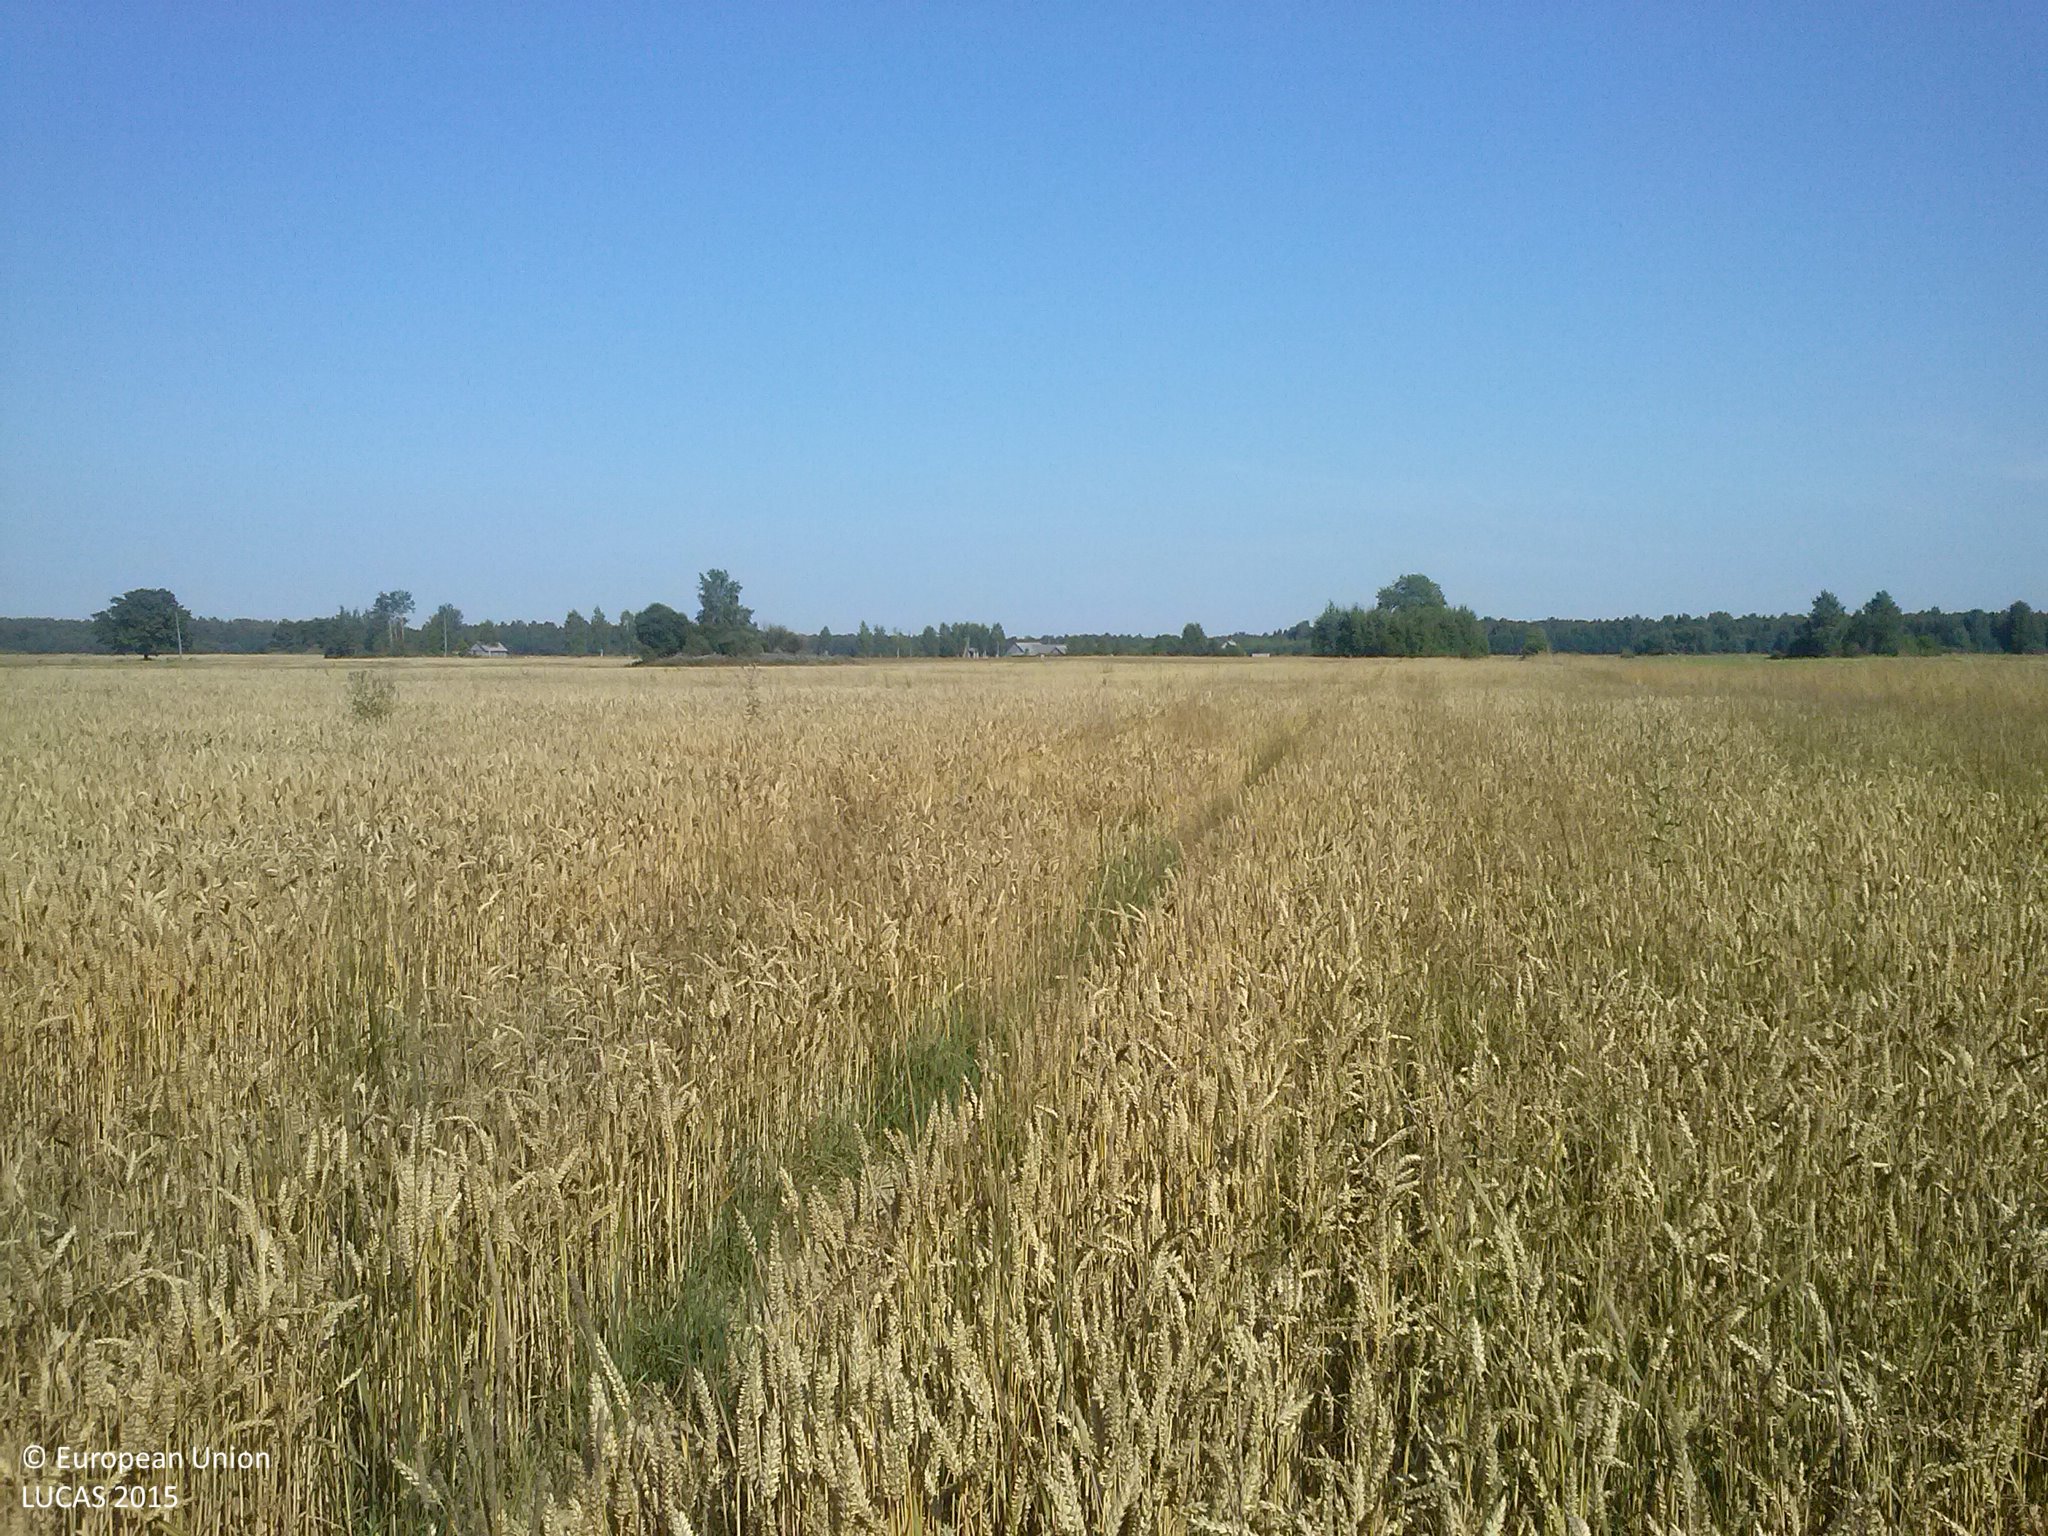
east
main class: Cropland
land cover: Common wheat
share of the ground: > 75 %
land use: Agriculture (excluding fallow land and kitchen gardens)
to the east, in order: Common wheat
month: August
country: LV
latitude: 56.6998
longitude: 27.8103
